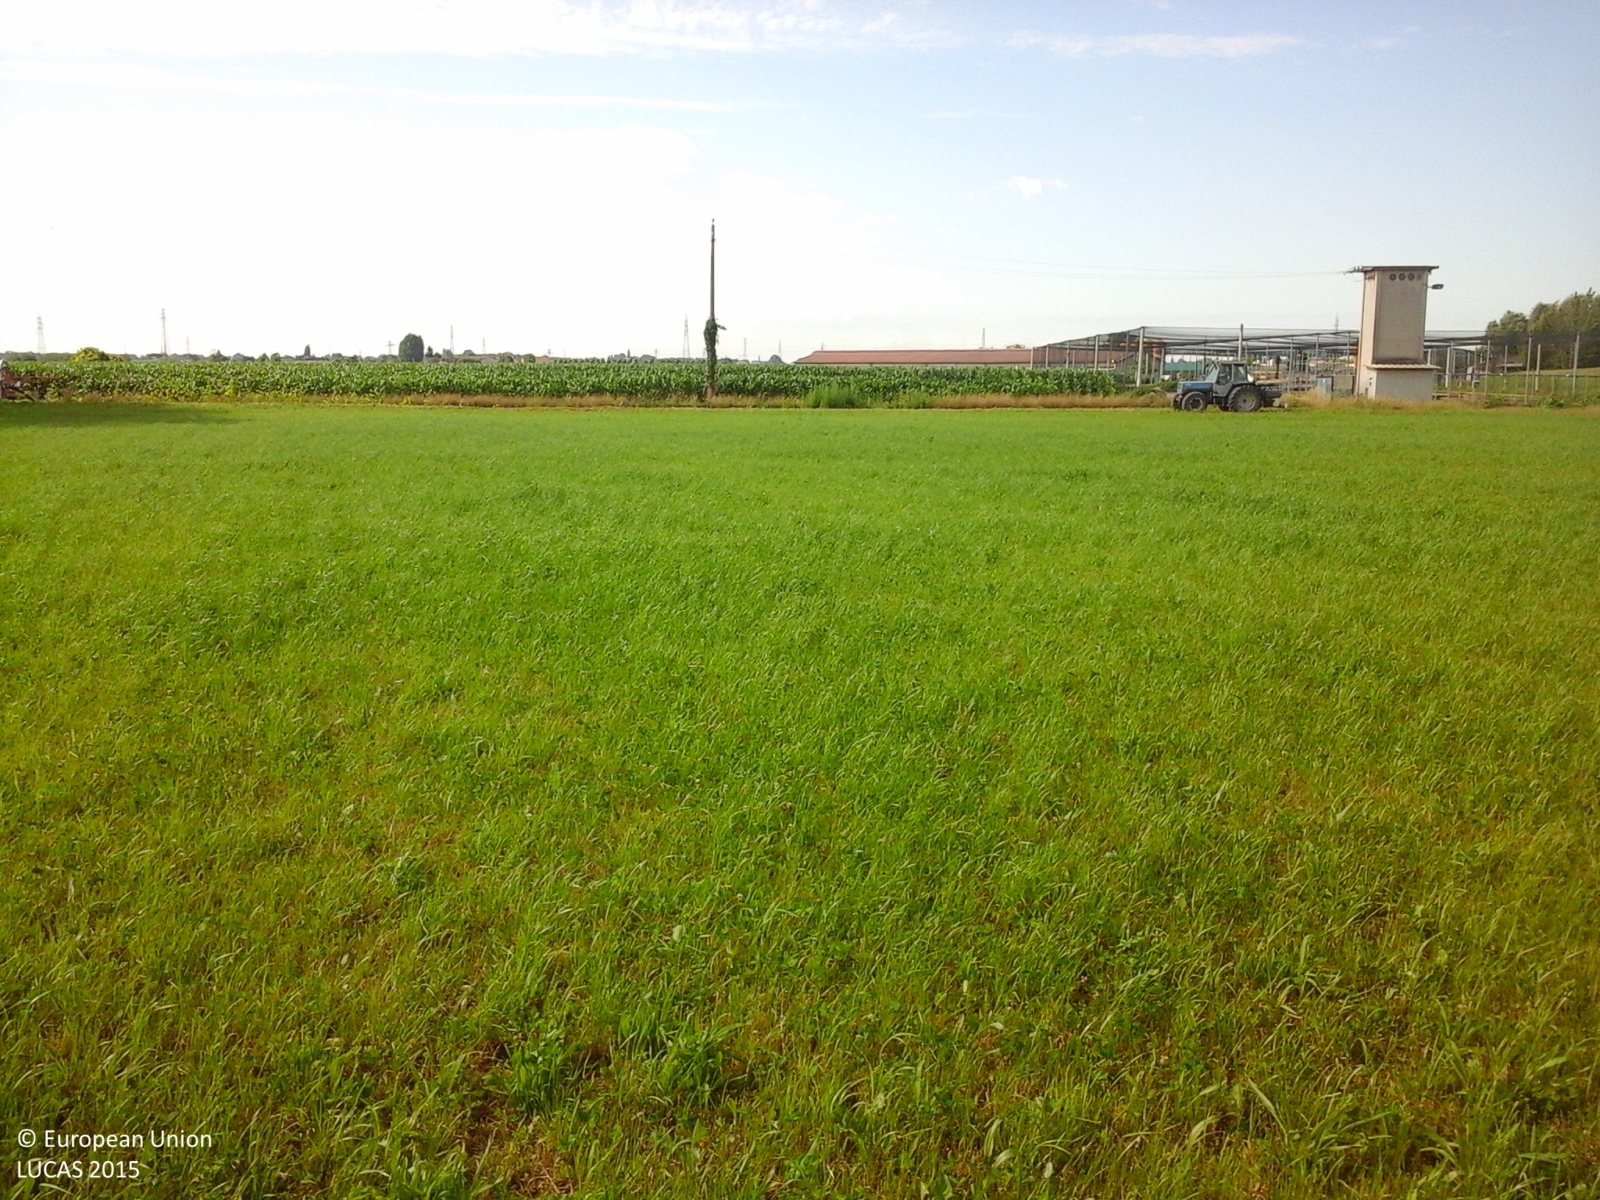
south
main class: Grassland
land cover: Grassland without tree/shrub cover
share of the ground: > 75 %
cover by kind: herbaceous plants 100 %
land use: Agriculture (excluding fallow land and kitchen gardens)
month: June
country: IT
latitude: 45.4085
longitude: 11.1097
